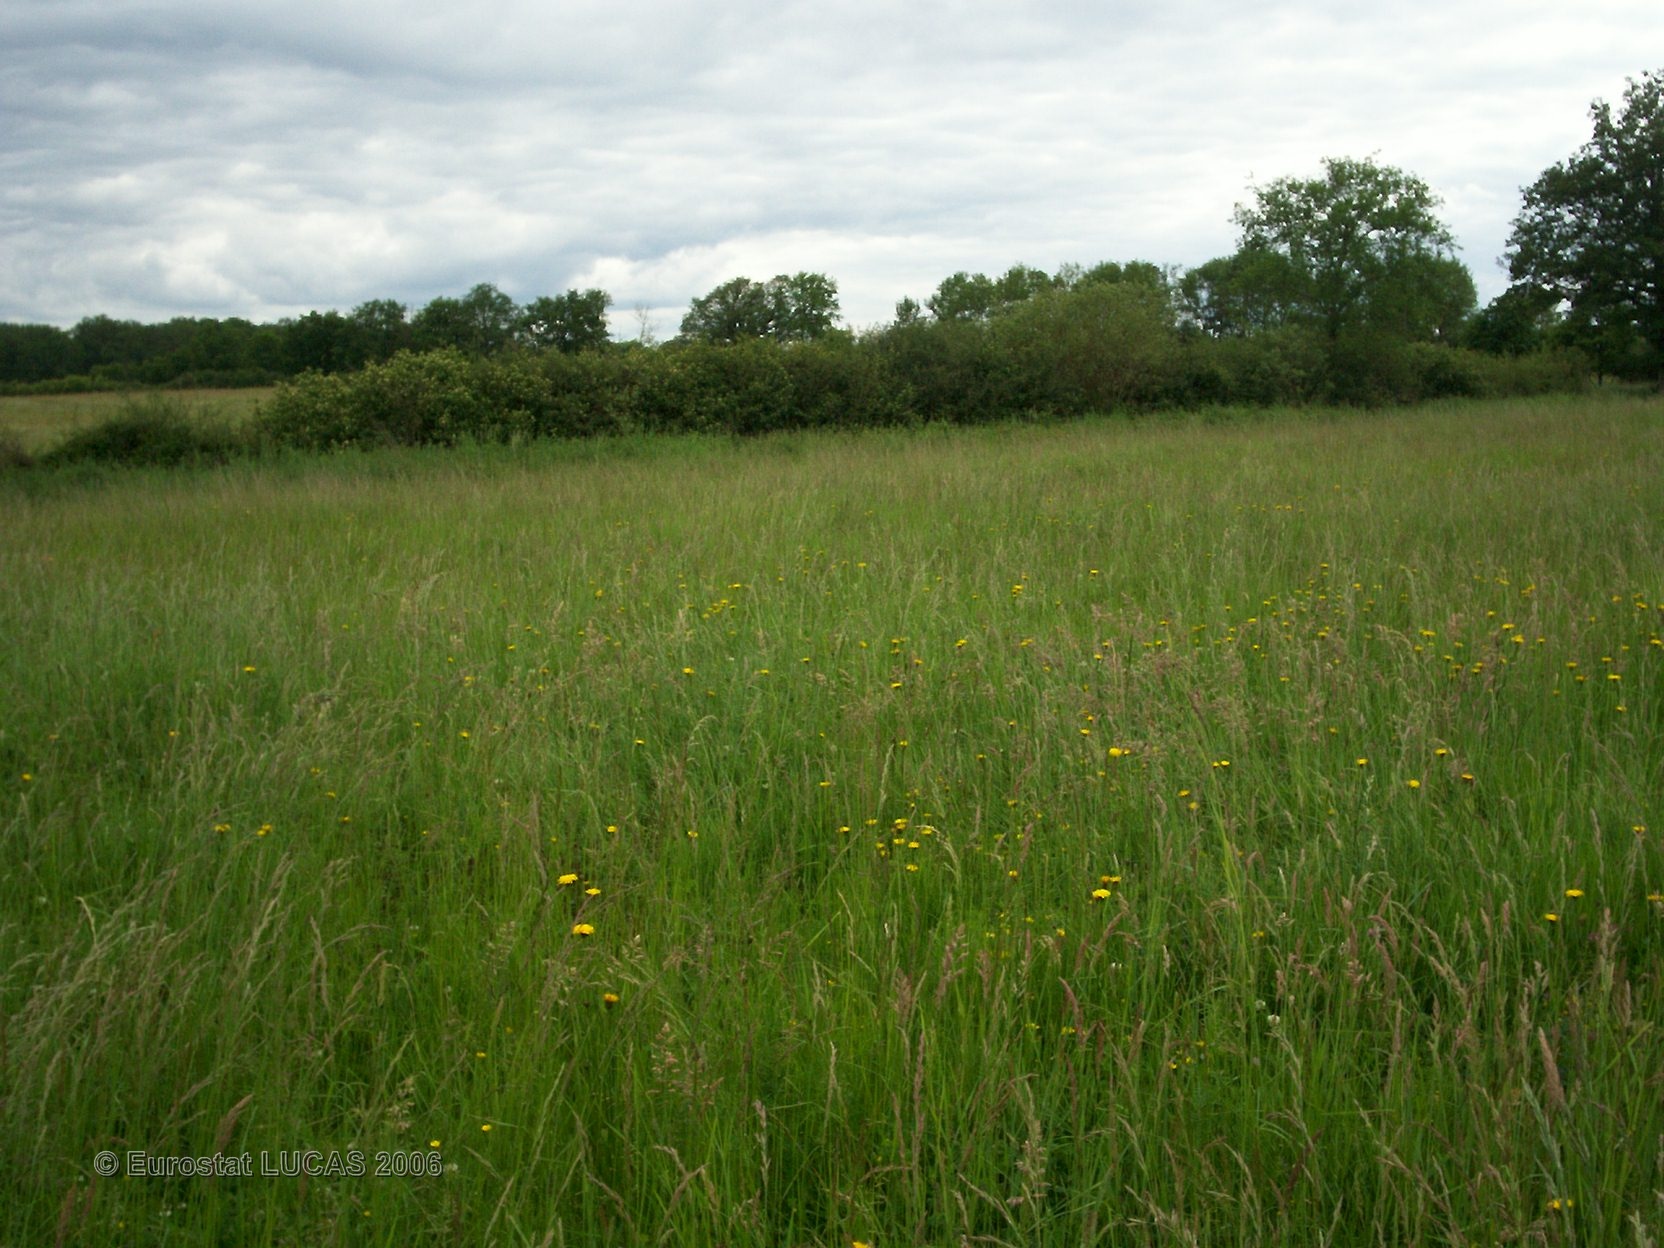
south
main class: Grassland
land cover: Grassland without tree/shrub cover
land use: Agriculture (excluding fallow land and kitchen gardens)
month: May
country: FR
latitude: 46.8648
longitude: 3.0304
